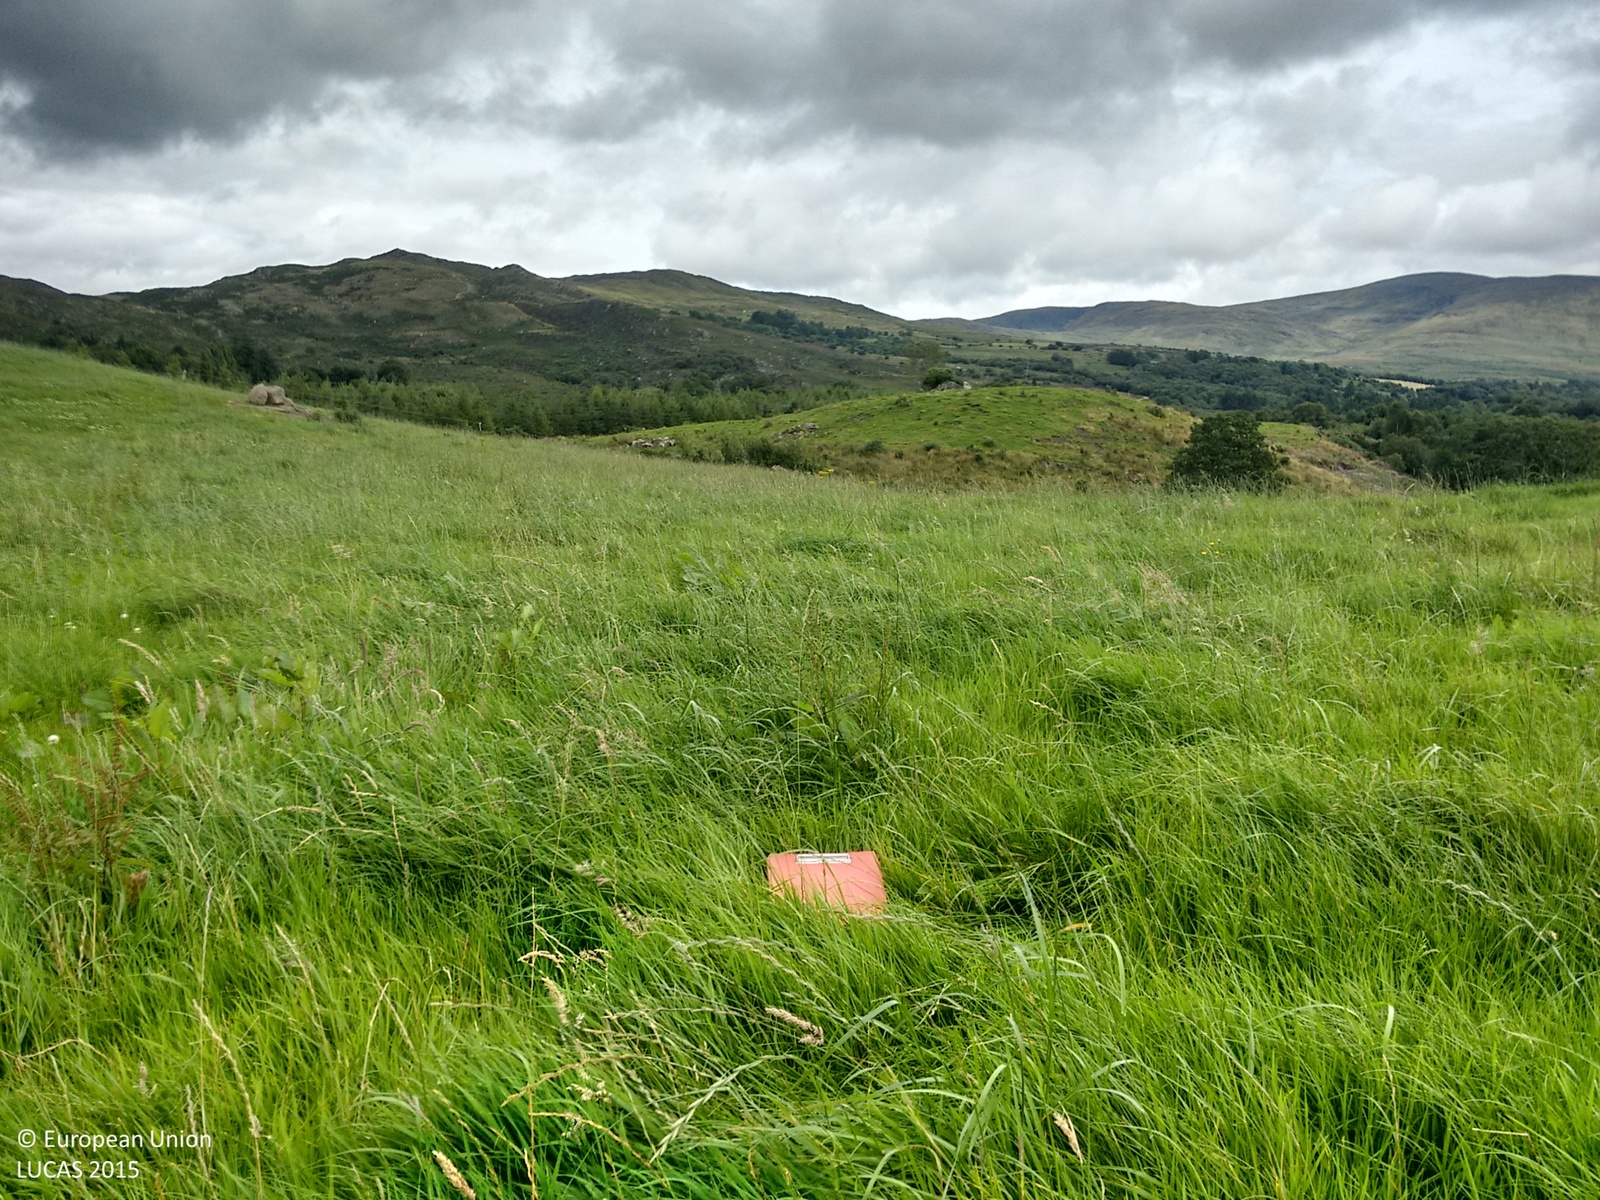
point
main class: Grassland
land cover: Grassland without tree/shrub cover
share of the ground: > 75 %
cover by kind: herbaceous plants 100 %
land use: Agriculture (excluding fallow land and kitchen gardens)
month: August
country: IE
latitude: 51.8612
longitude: -9.5325
